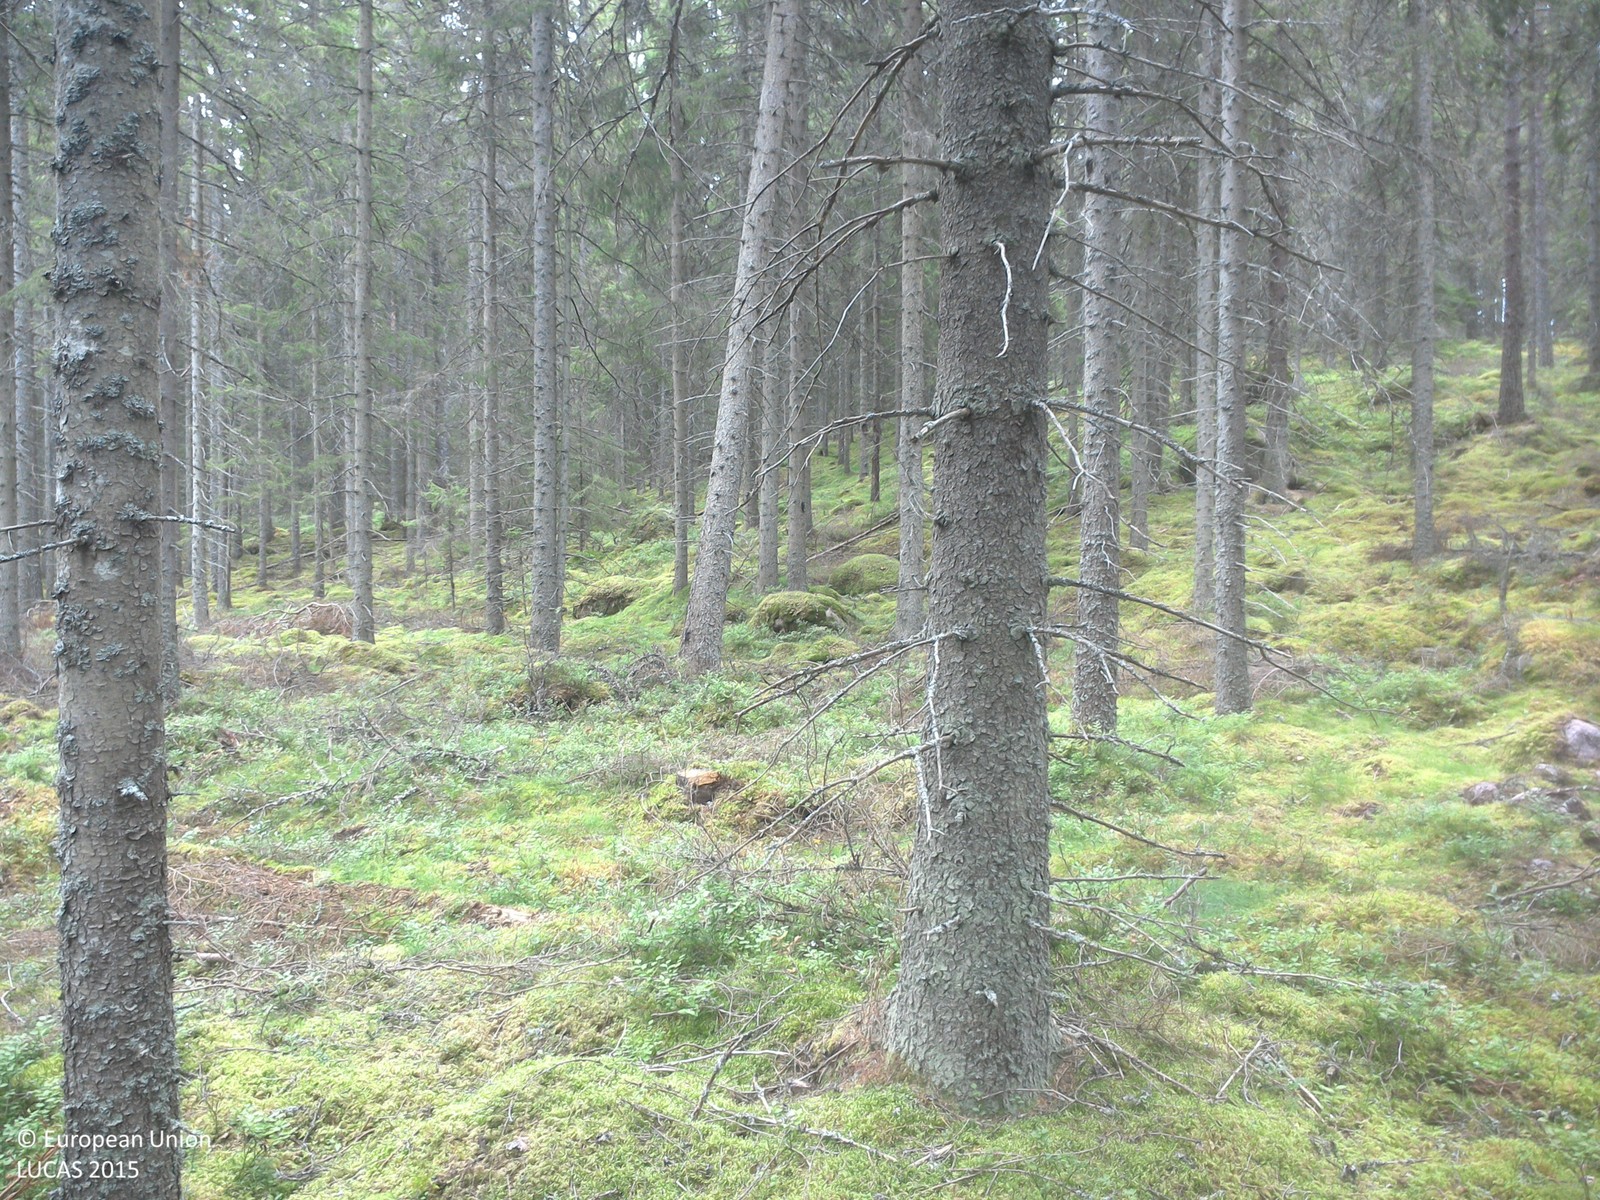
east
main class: Woodland
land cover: Spruce dominated coniferous woodland
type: boreal forest
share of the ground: 50 - 75 %
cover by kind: coniferous forest trees 65 %, lichens and mosses 25 %, herbaceous plants 10 %
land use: Forestry
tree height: > 5 m
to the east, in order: Spruce dominated coniferous woodland; Tracks; Spruce dominated coniferous woodland; Tracks; Spruce dominated coniferous woodland; Tracks; Spruce dominated mixed woodland
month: August
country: SE
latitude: 57.7536
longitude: 15.3227
